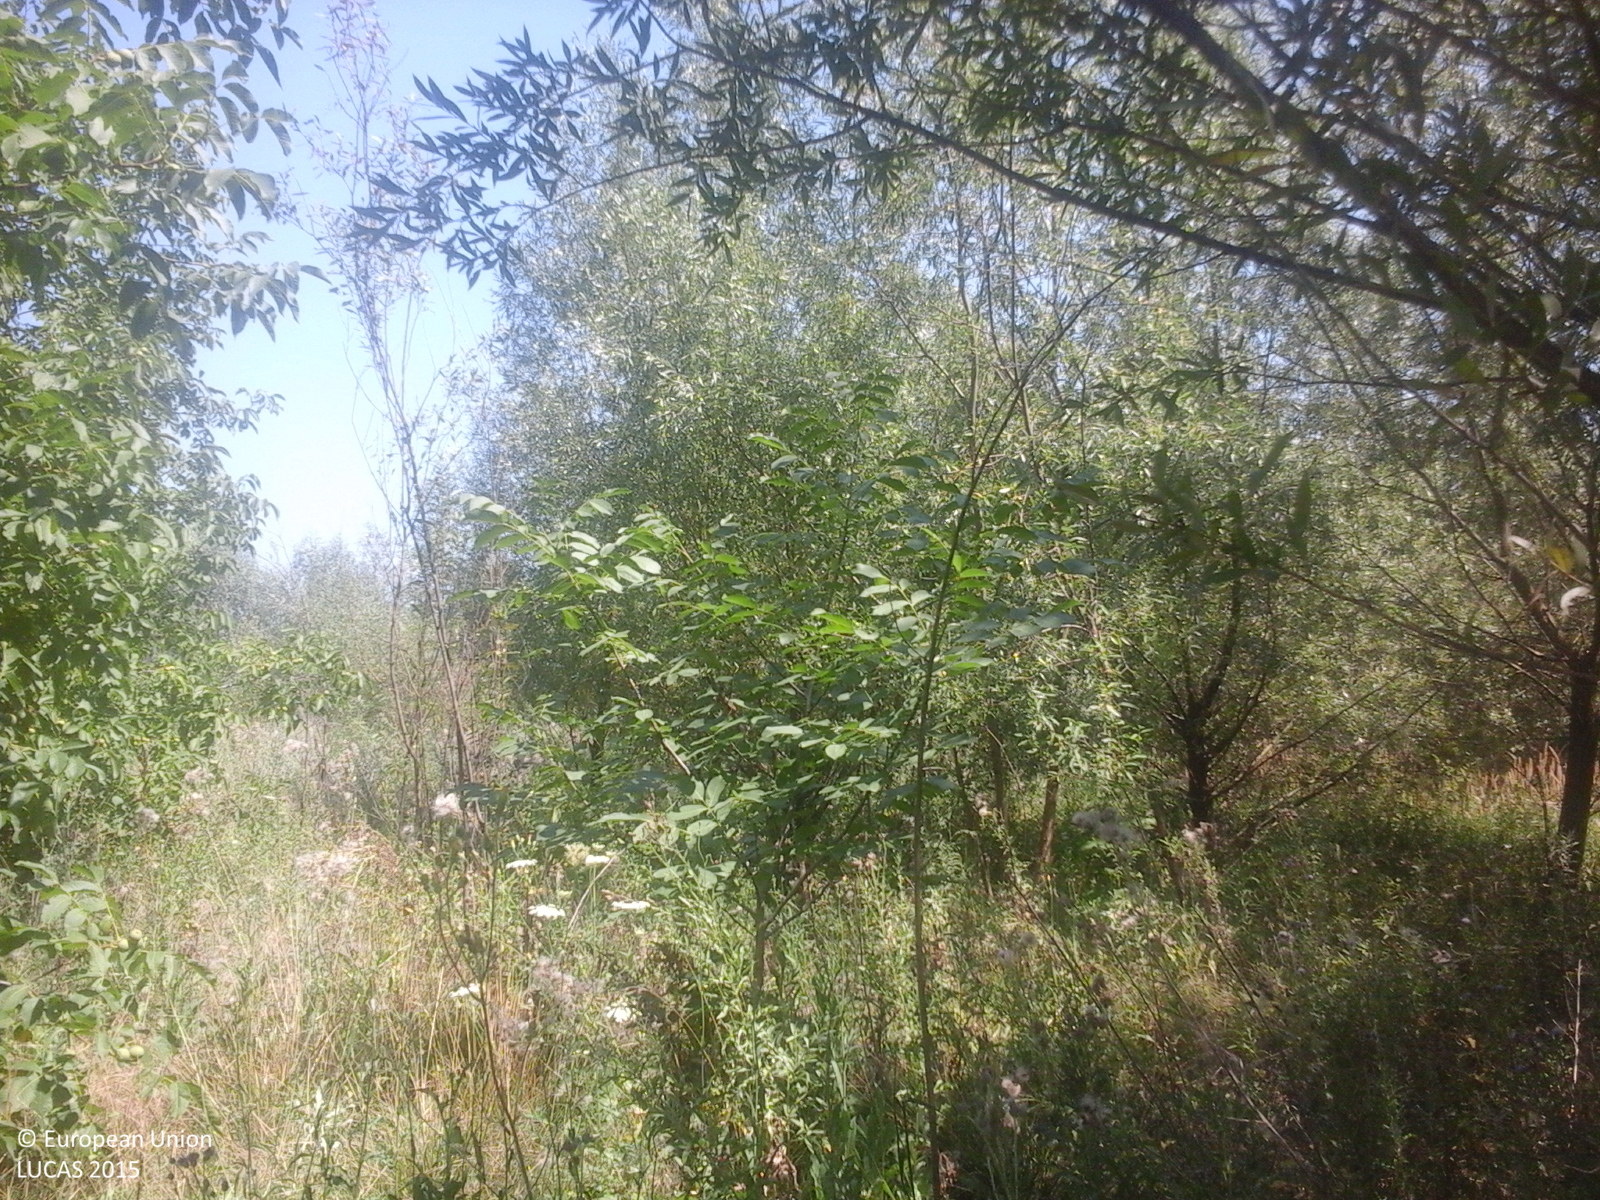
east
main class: Cropland
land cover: Permanent industrial crops
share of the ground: > 75 %
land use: Agriculture (excluding fallow land and kitchen gardens)
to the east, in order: Permanent industrial crops
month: July
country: RO
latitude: 44.2142
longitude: 27.1645
